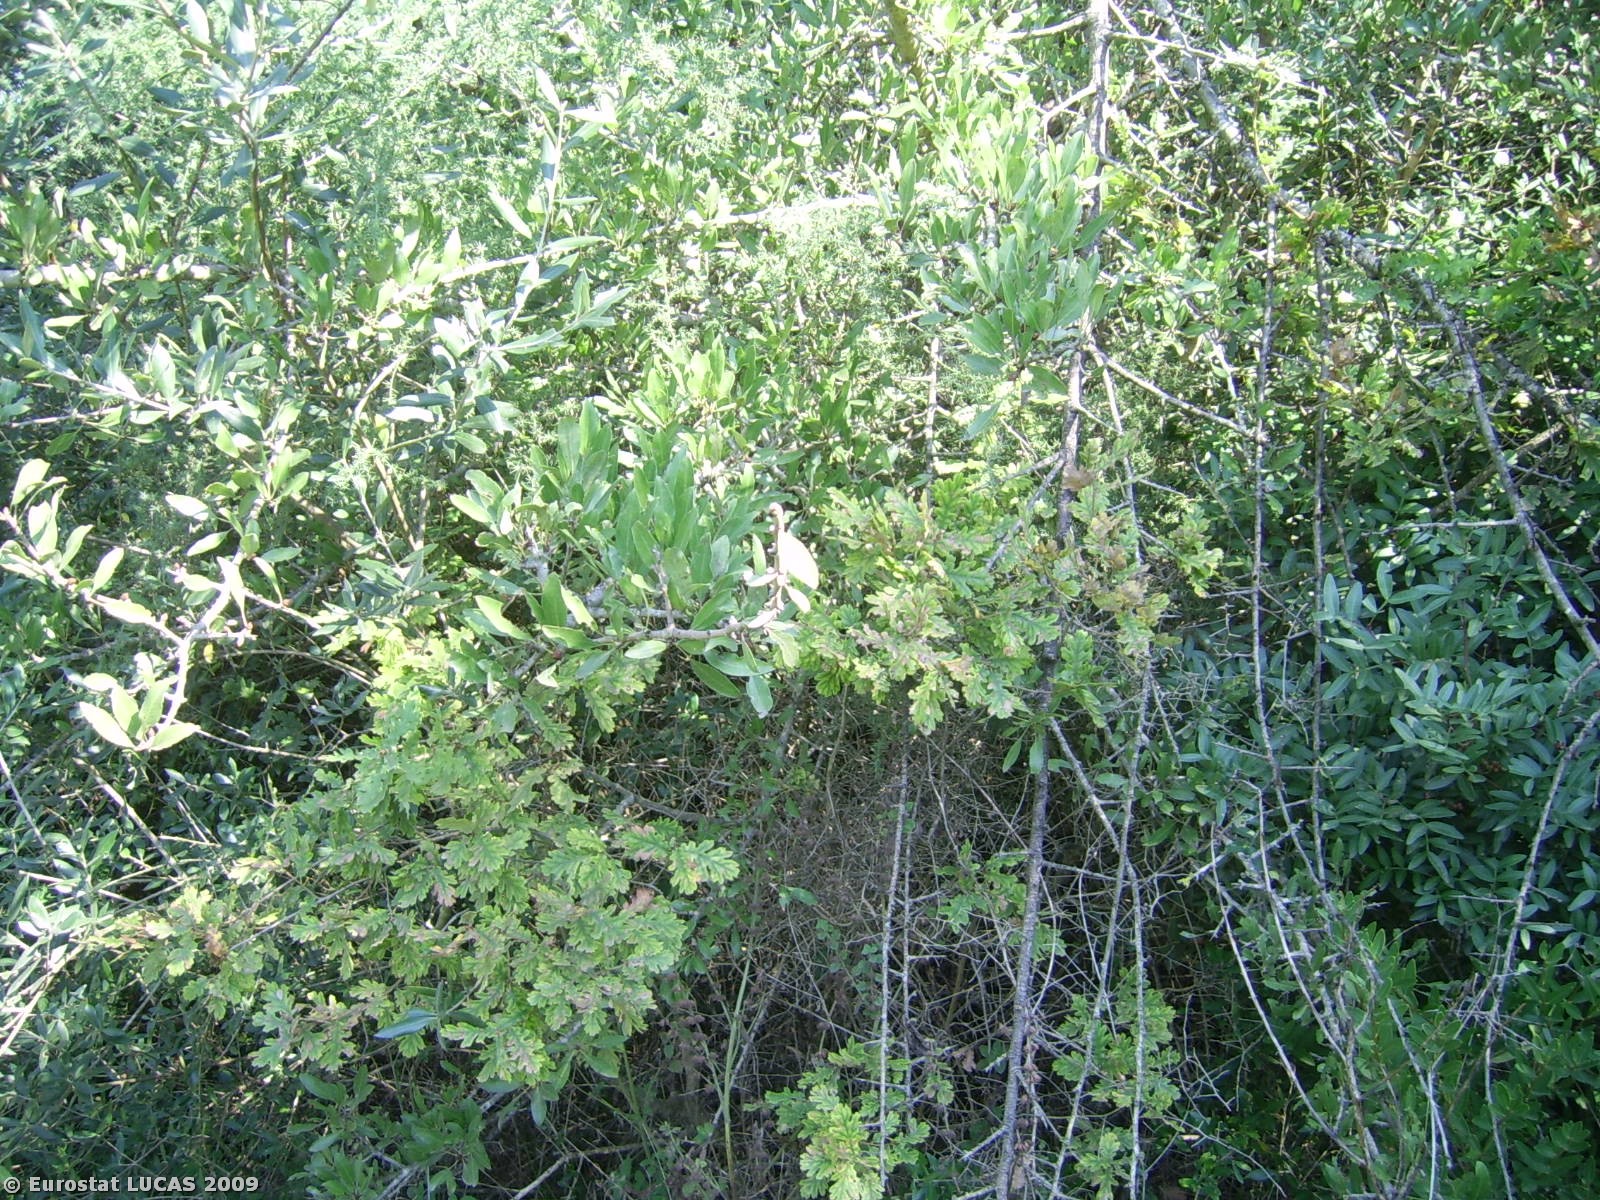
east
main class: Shrubland
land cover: Shrubland with sparse tree cover
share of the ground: > 75 %
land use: Unused
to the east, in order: Shrubland with sparse tree cover; Olive groves; Grassland with sparse tree/shrub cover; Other fresh vegetables; Tracks; Olive groves; Grassland with sparse tree/shrub cover; Coniferous woodland; Electric lines; Grass margins; Paved roads, cycling and walking lanes; Grass margins; Vineyards; Grassland with sparse tree/shrub cover
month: October
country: GR
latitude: 37.8279
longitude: 21.4014
